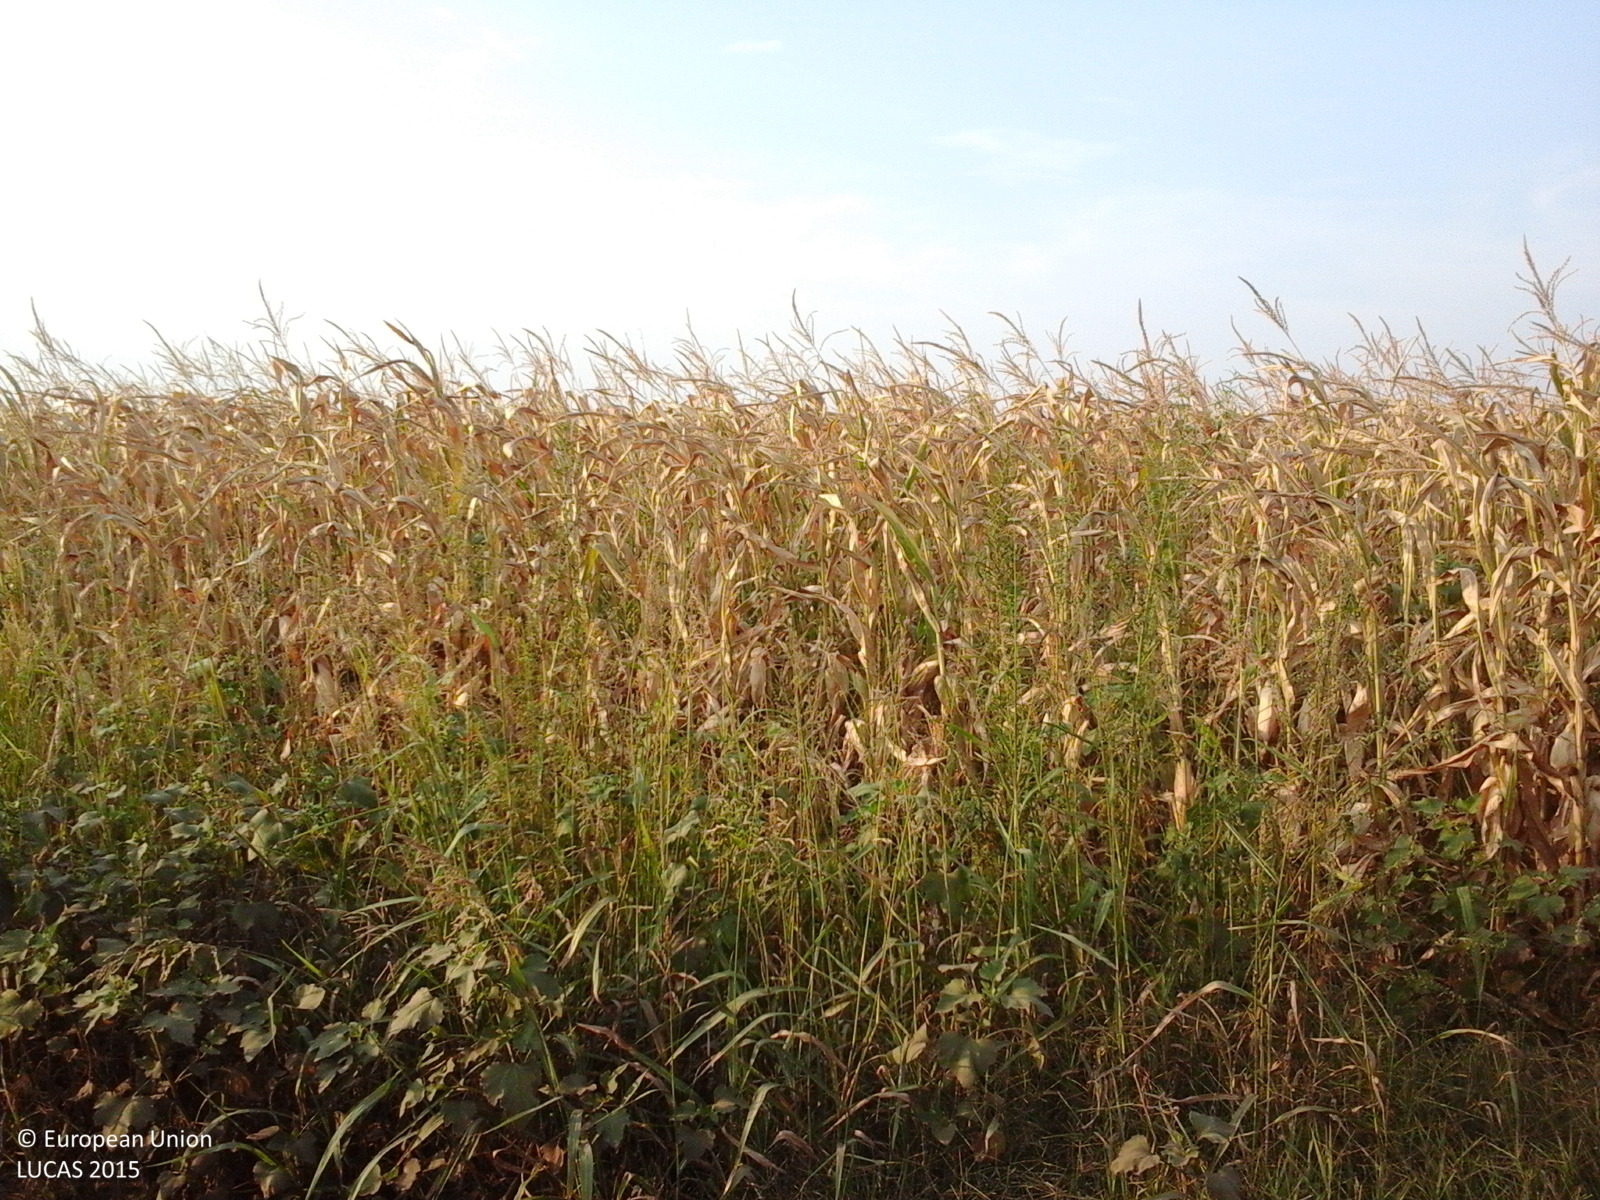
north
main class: Cropland
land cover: Maize
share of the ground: > 75 %
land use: Agriculture (excluding fallow land and kitchen gardens)
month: August
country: RO
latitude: 43.9928
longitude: 23.2249
